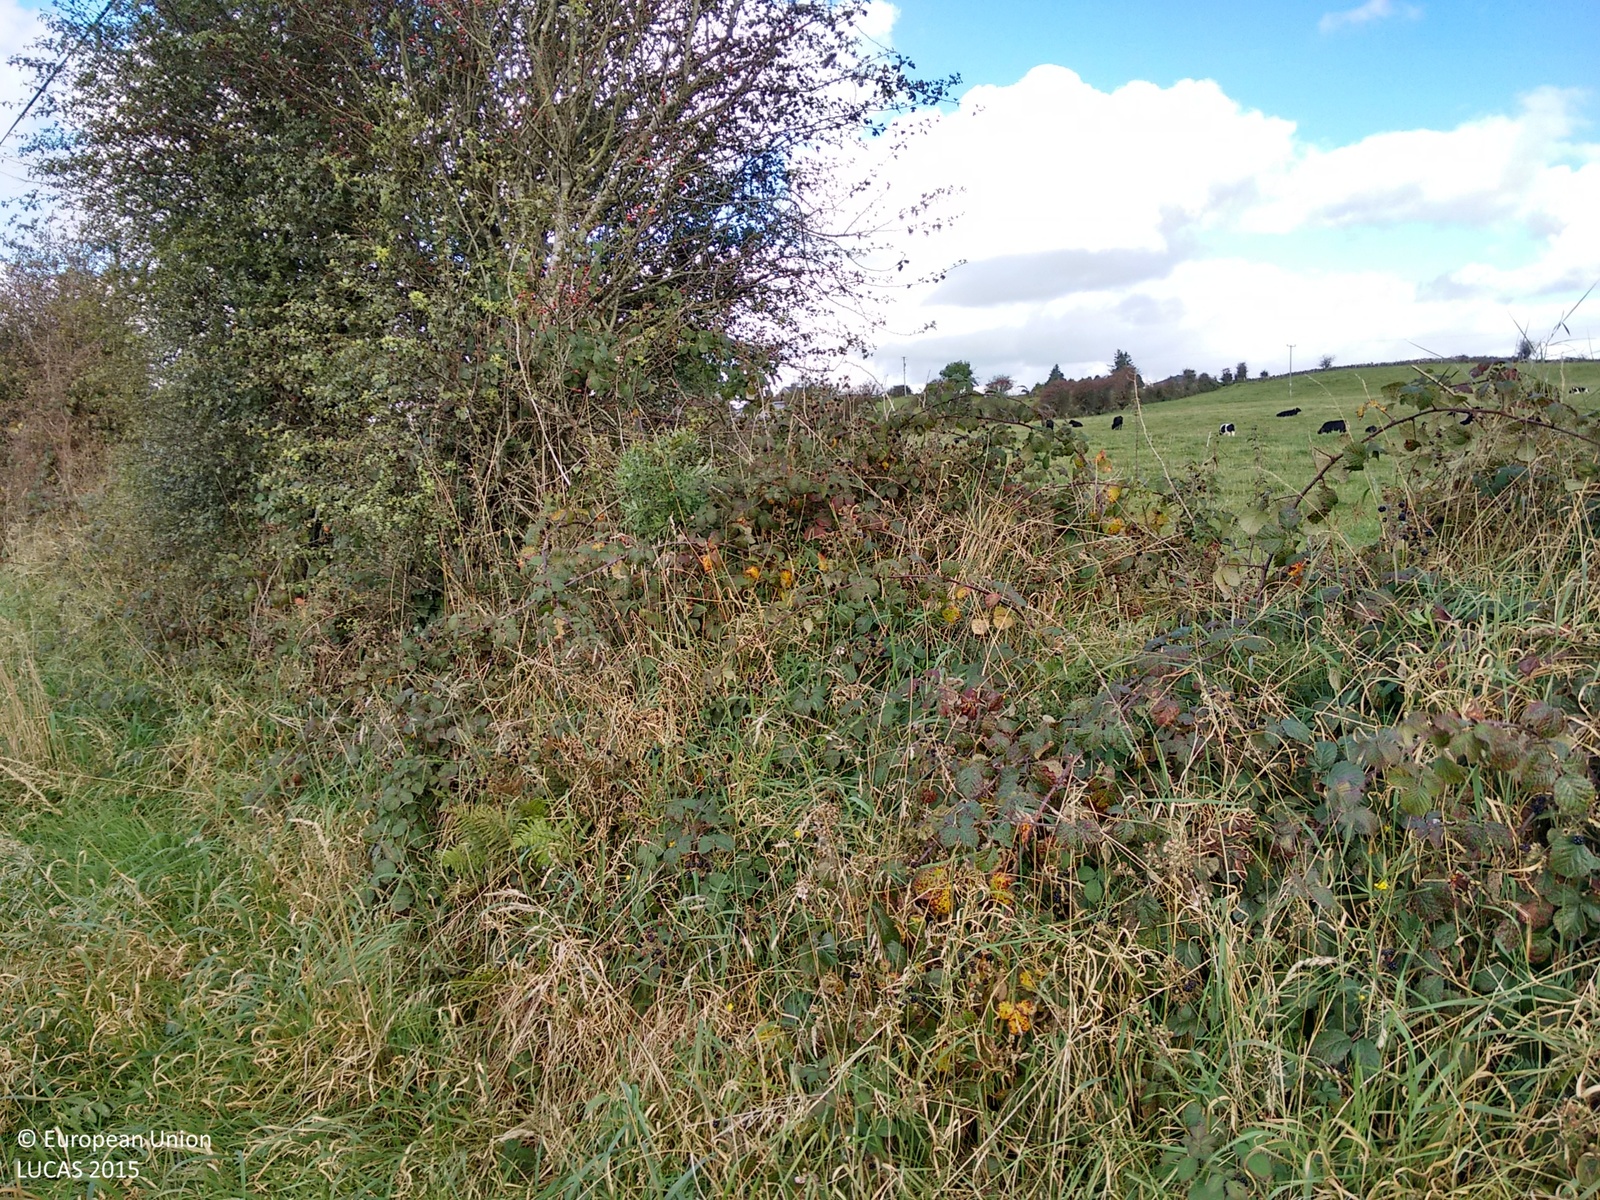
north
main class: Grassland
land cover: Grassland without tree/shrub cover
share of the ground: > 75 %
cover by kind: herbaceous plants 100 %
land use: Agriculture (excluding fallow land and kitchen gardens)
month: October
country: IE
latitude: 53.8654
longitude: -8.2331
